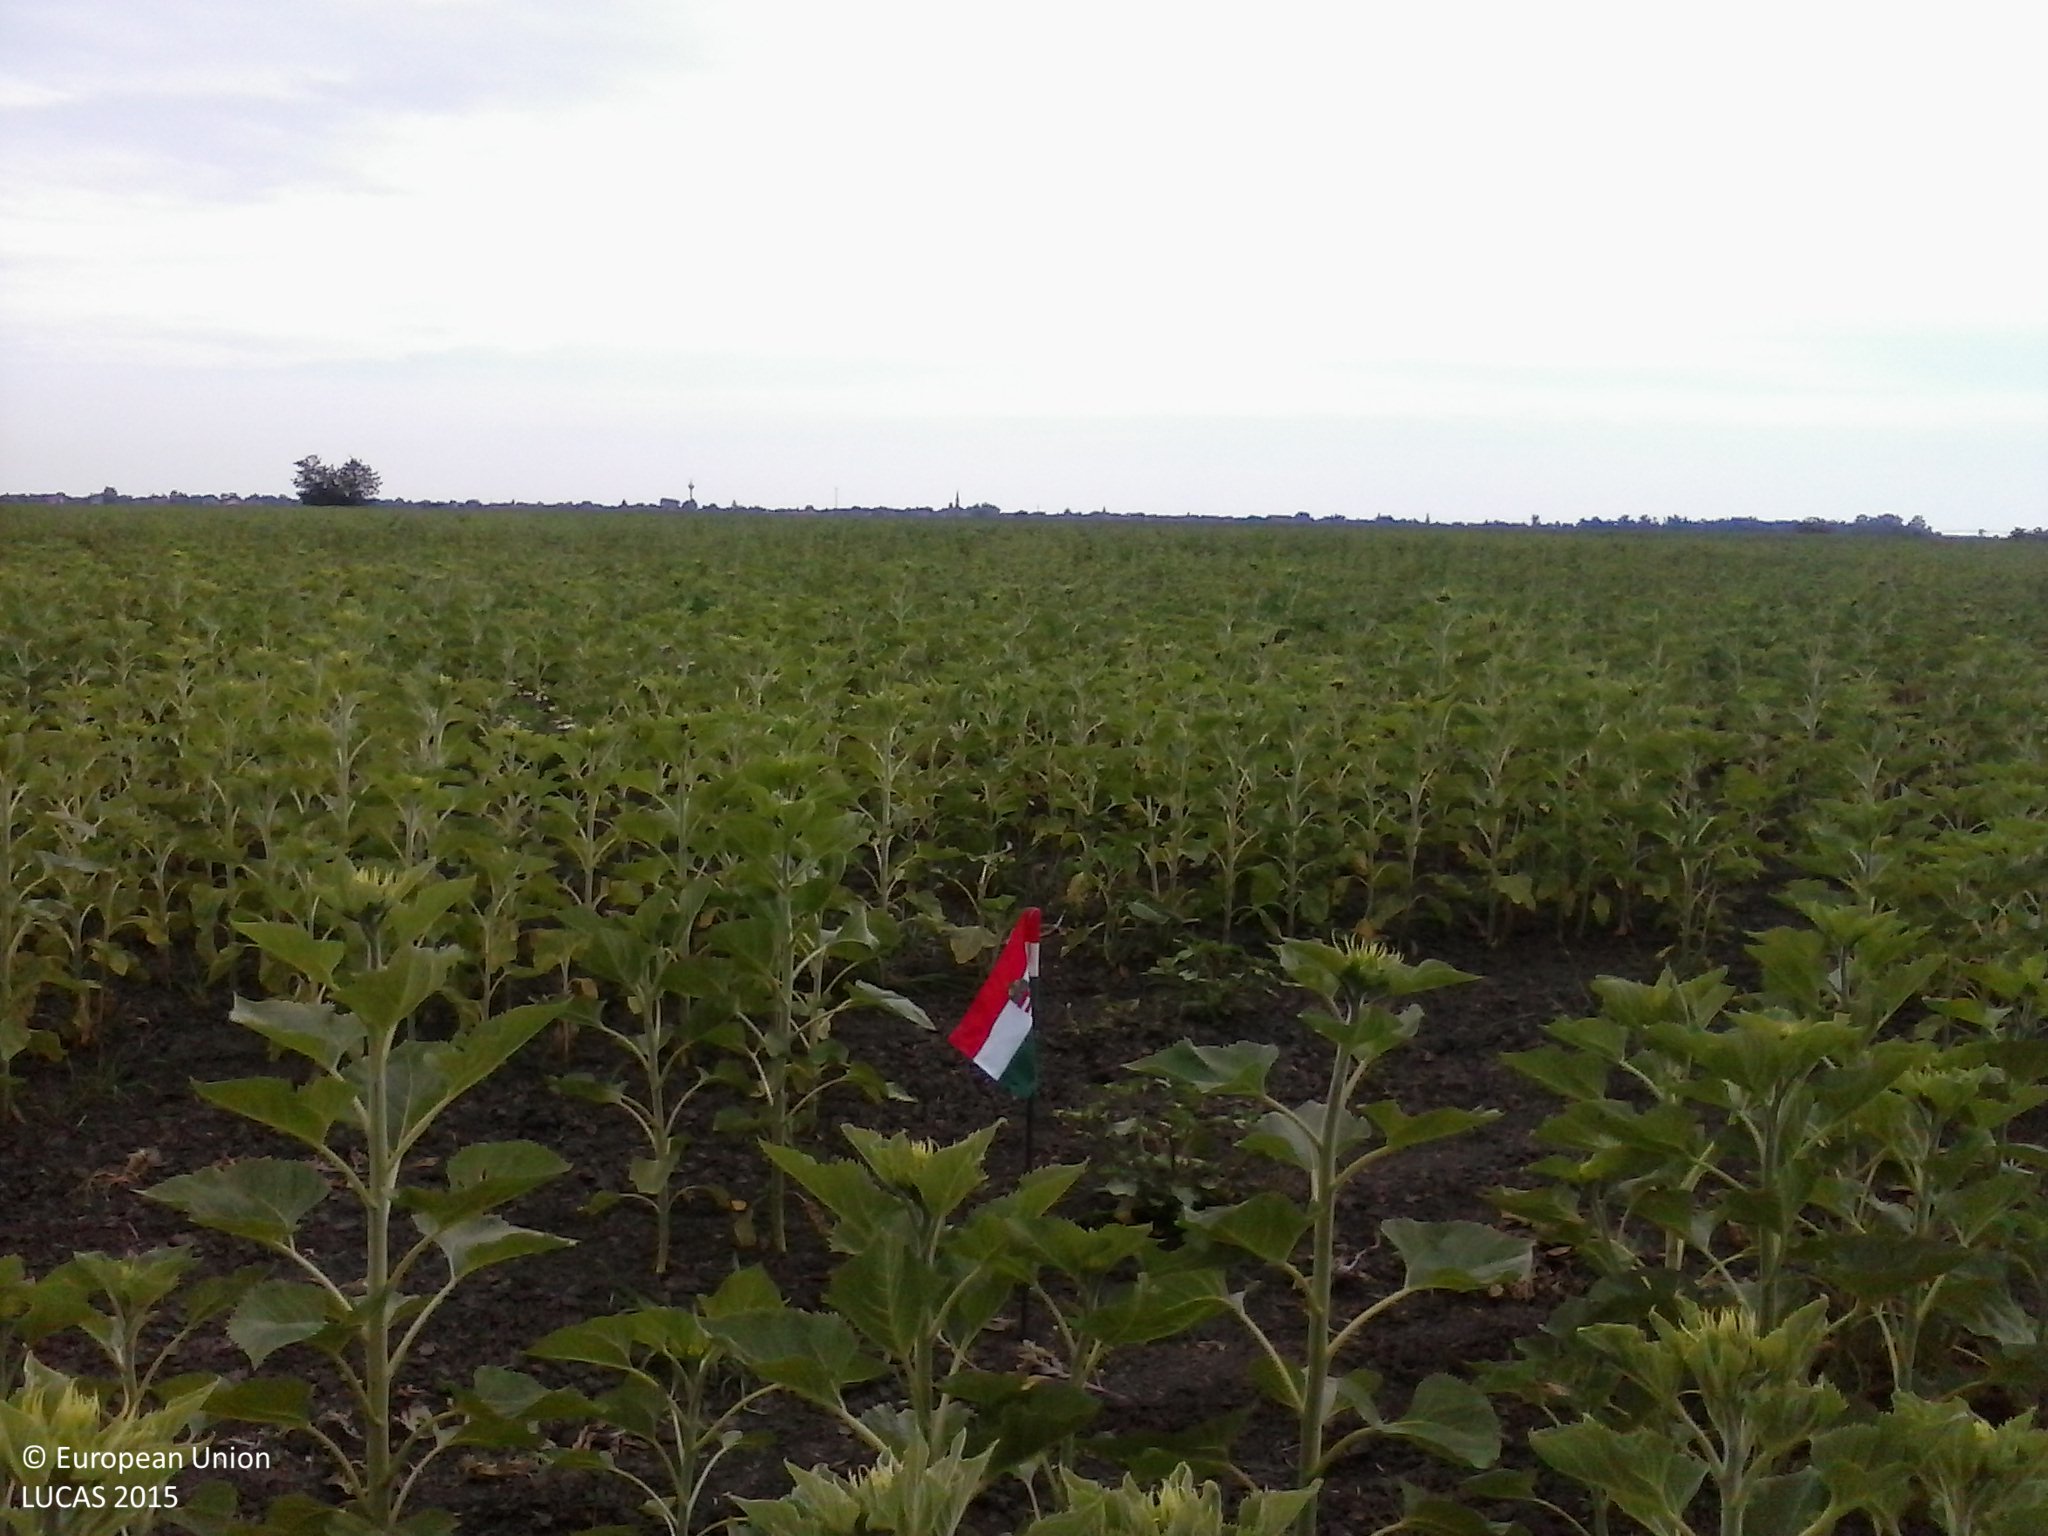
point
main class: Cropland
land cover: Sunflower
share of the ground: > 75 %
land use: Agriculture (excluding fallow land and kitchen gardens)
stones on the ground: < 10 %
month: June
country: HU
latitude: 46.2689
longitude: 20.3131
